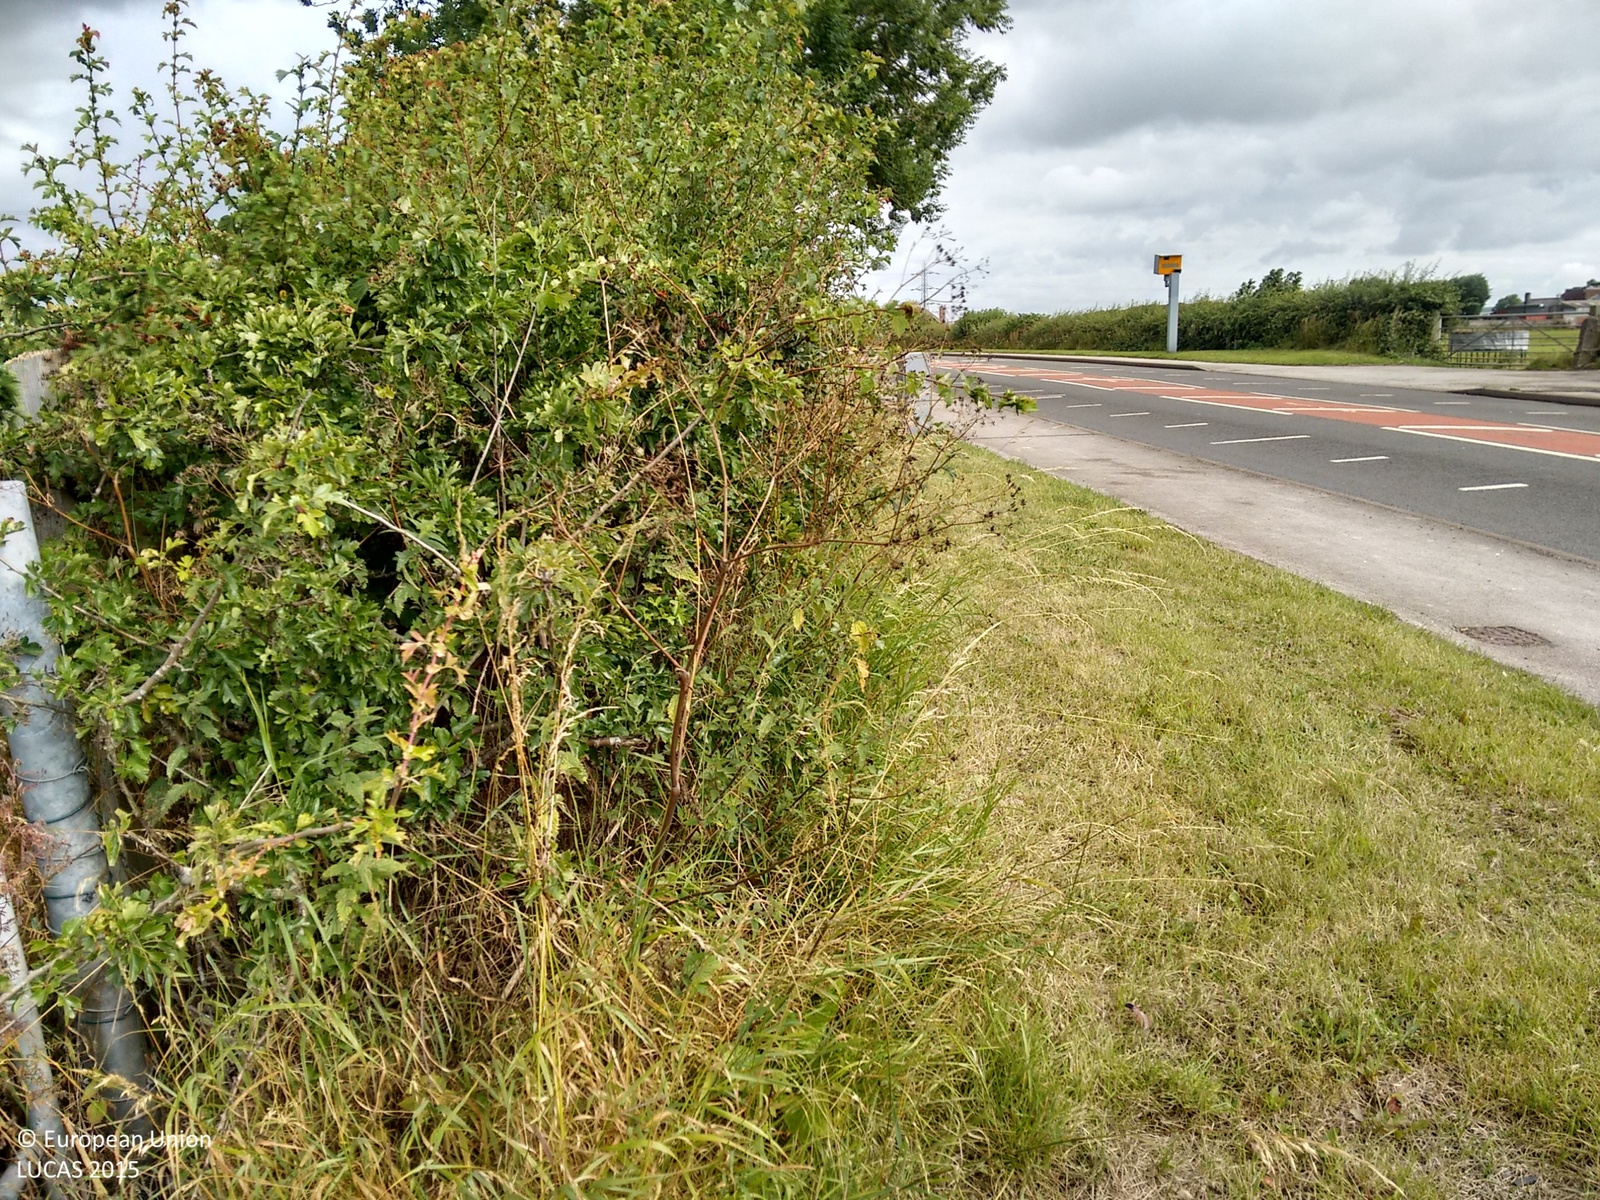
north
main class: Cropland
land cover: Common wheat
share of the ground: > 75 %
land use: Agriculture (excluding fallow land and kitchen gardens)
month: July
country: GB
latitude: 52.6376
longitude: -2.0130
